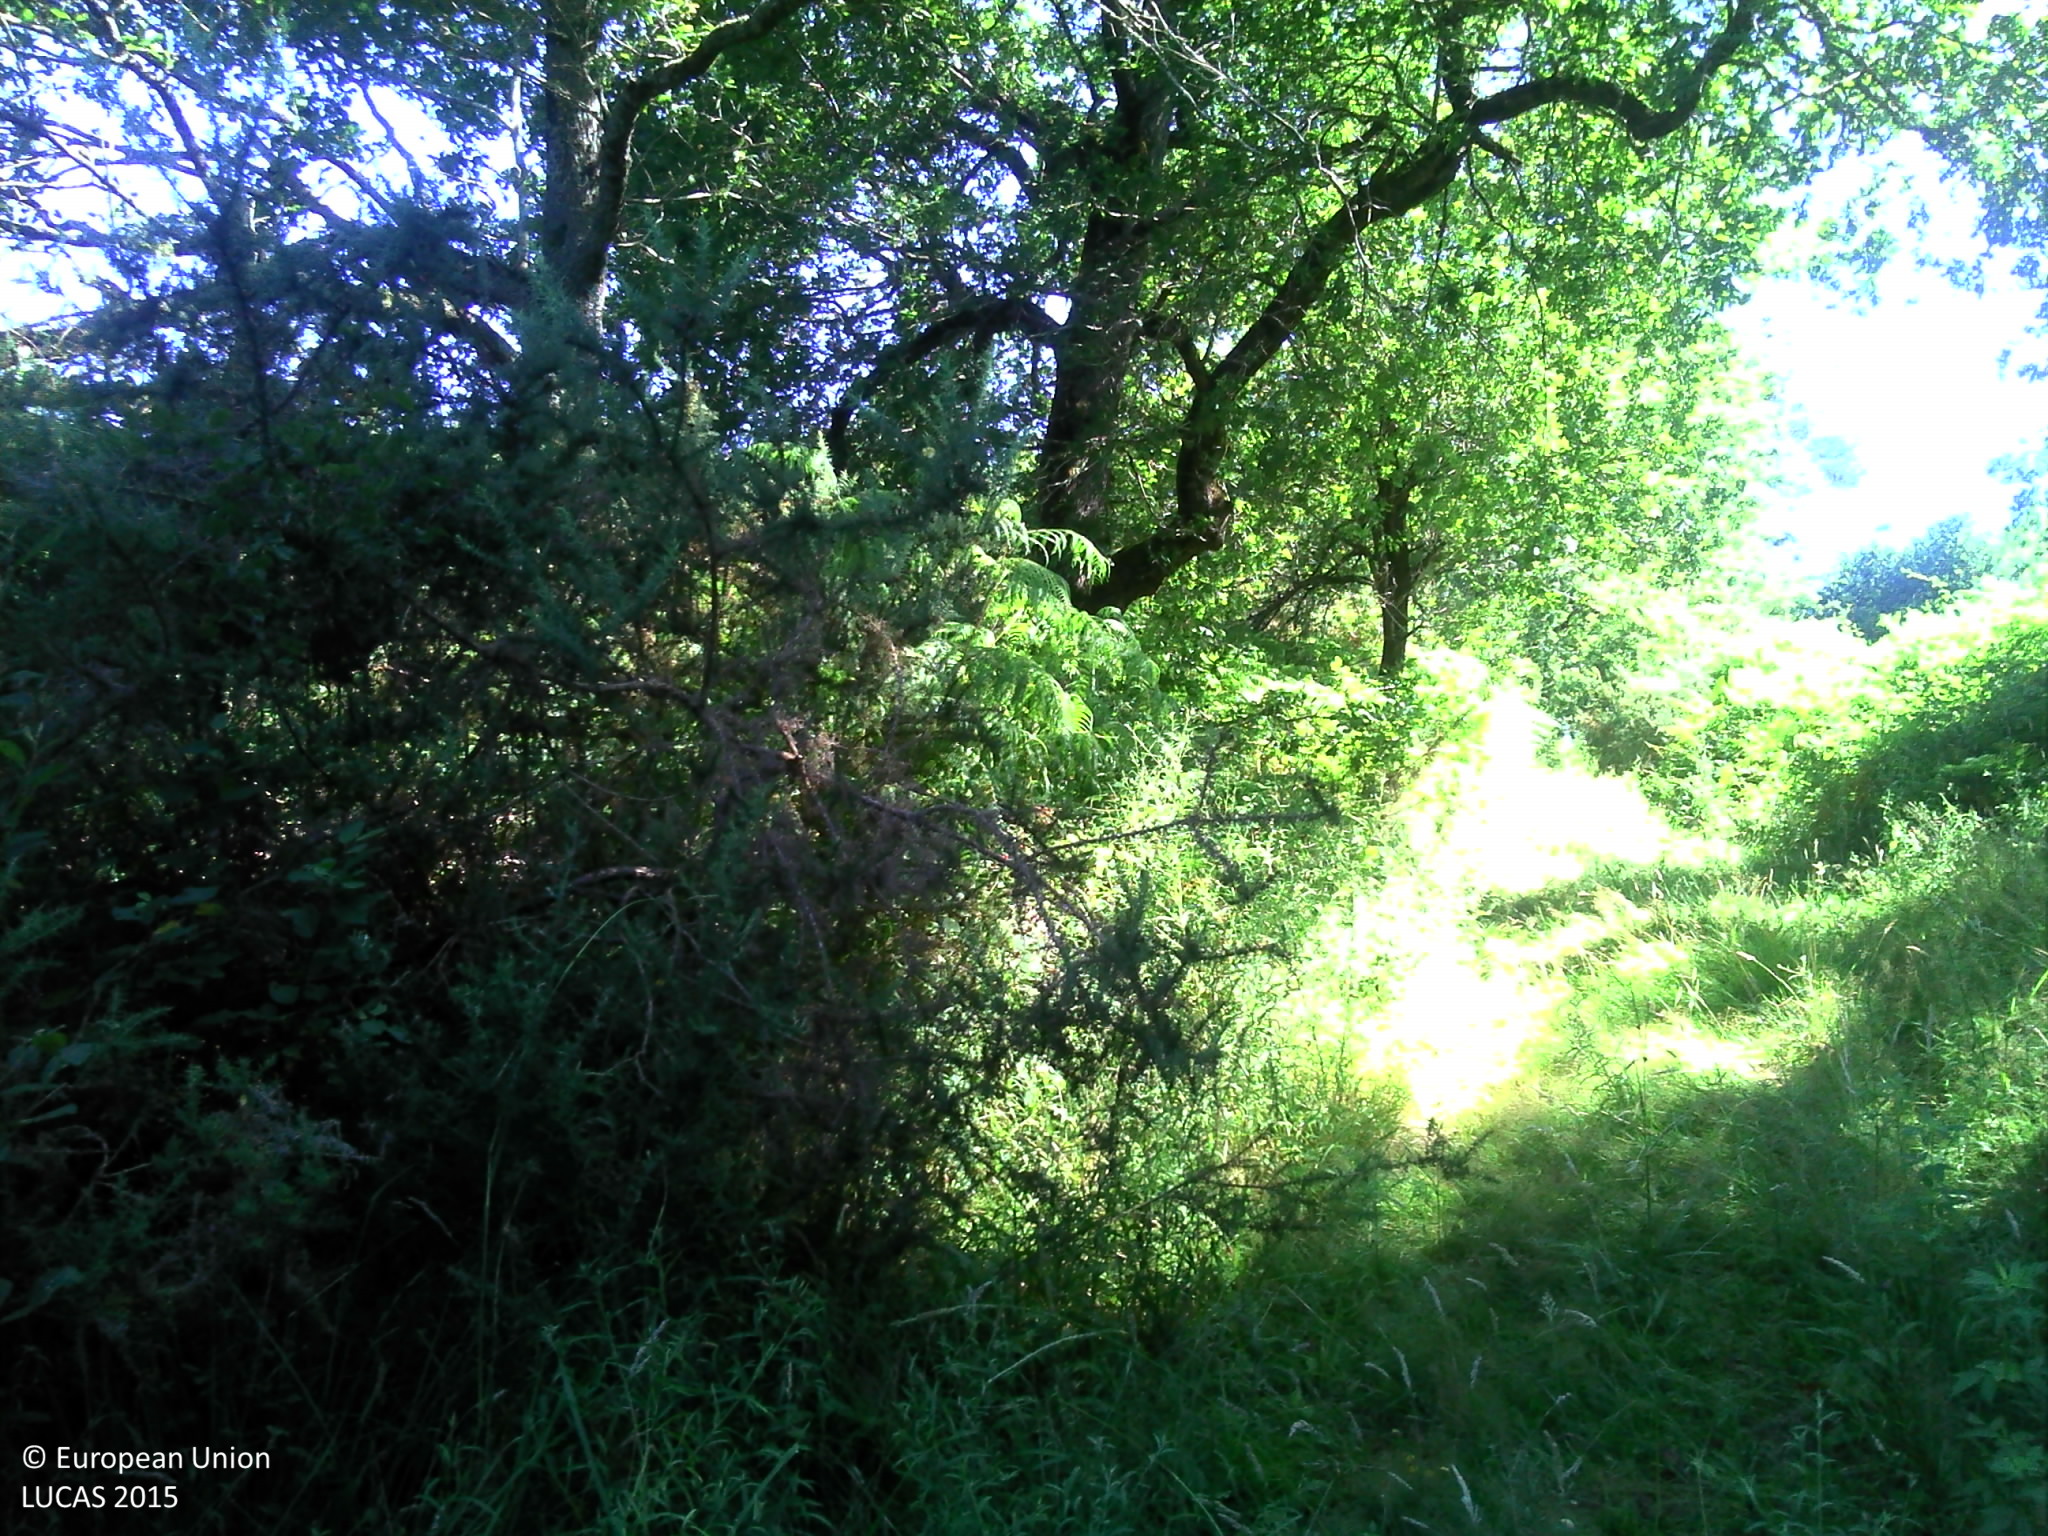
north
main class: Shrubland
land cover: Shrubland with sparse tree cover
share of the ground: > 75 %
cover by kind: shrubs 60 %, herbaceous plants 35 %, broadleaved forest trees 5 %
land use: Semi-natural and natural areas not in use
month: July
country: FR
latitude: 43.5893
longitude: -1.1005
